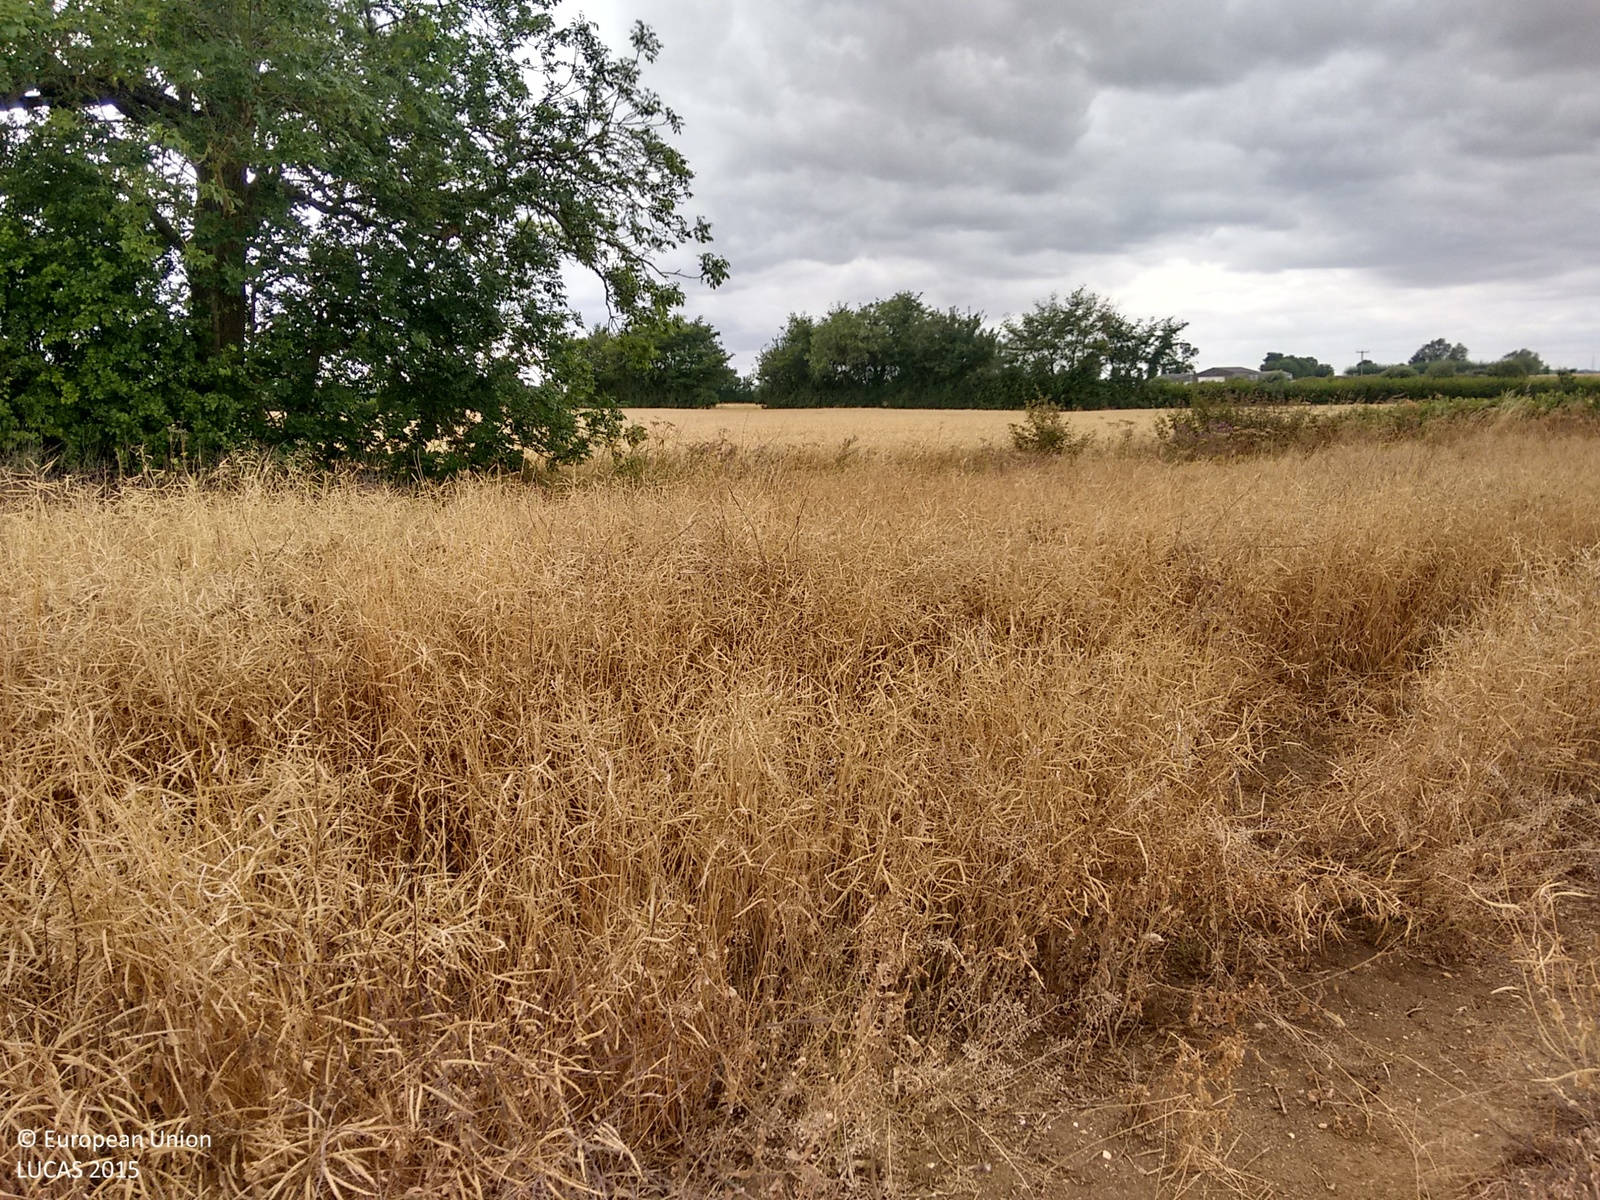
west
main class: Cropland
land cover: Rape and turnip rape
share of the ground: > 75 %
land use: Agriculture (excluding fallow land and kitchen gardens)
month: August
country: GB
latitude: 52.0282
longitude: 0.4543
